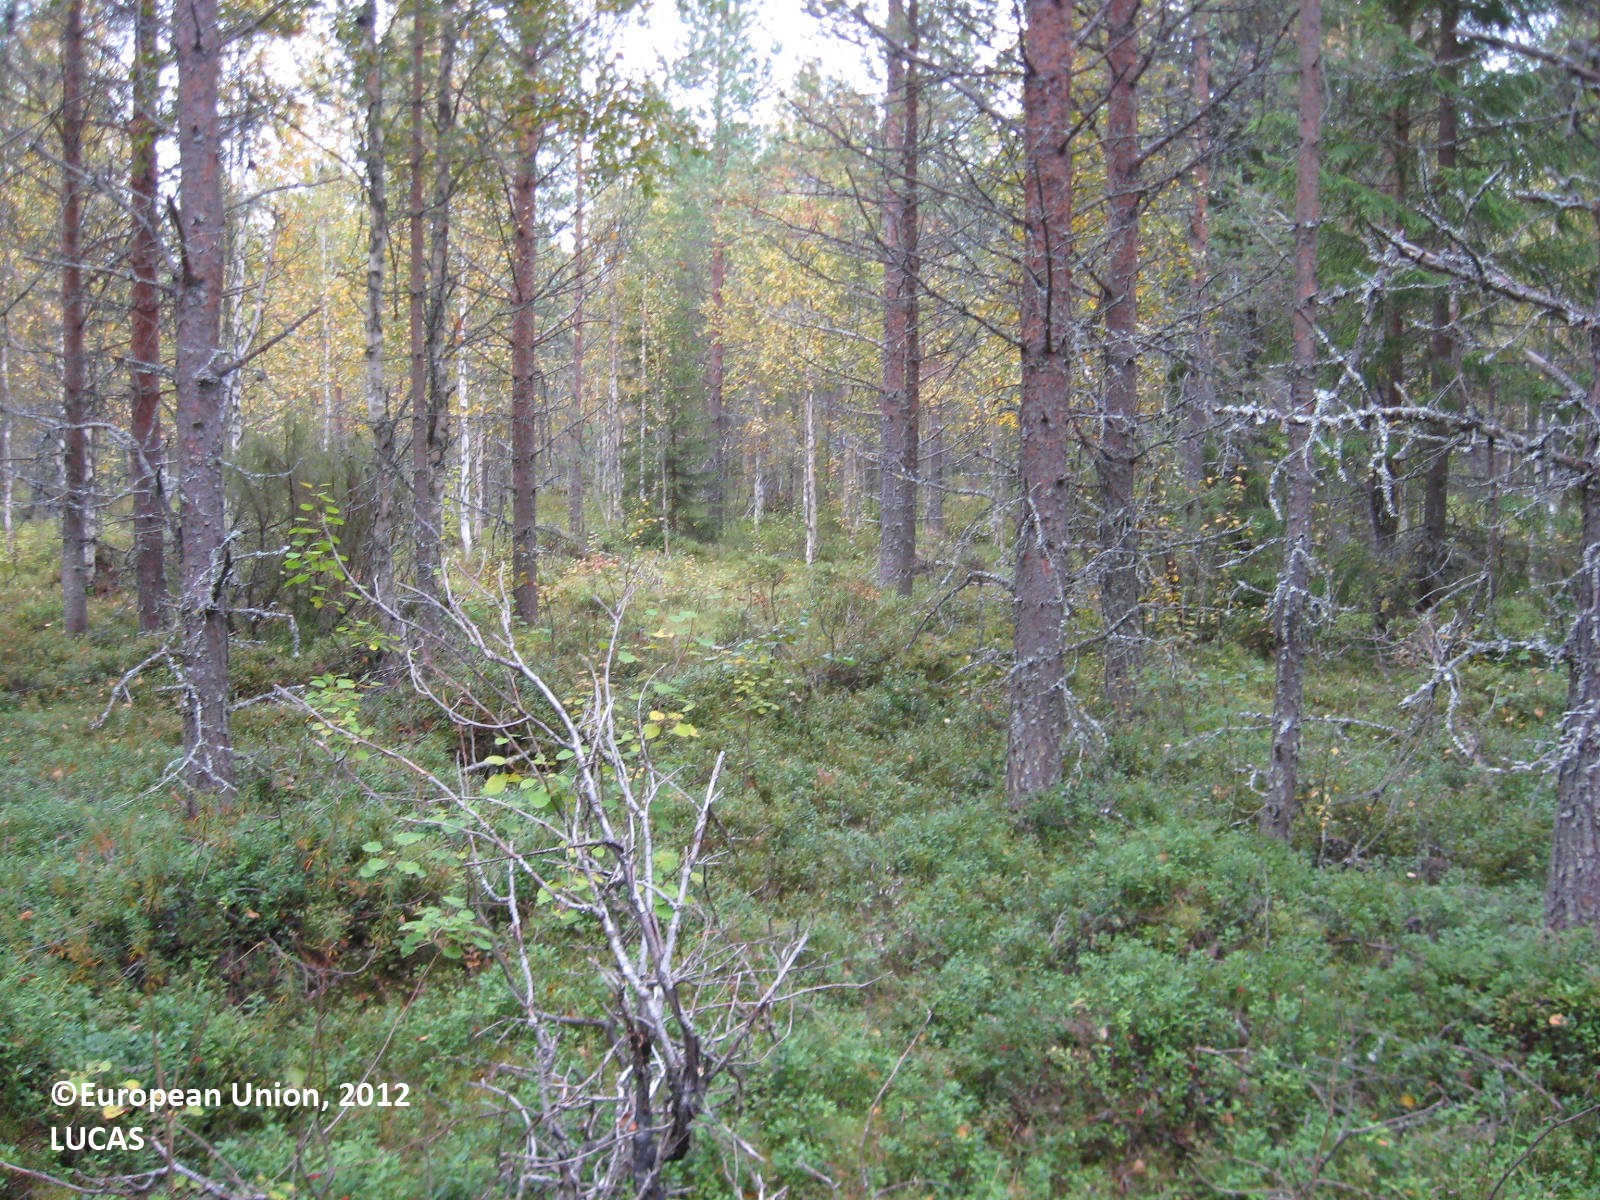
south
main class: Woodland
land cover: Pine dominated mixed woodland
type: boreal forest
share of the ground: > 75 %
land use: Forestry
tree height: > 5 m
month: August
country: FI
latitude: 63.9262
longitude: 29.5767
